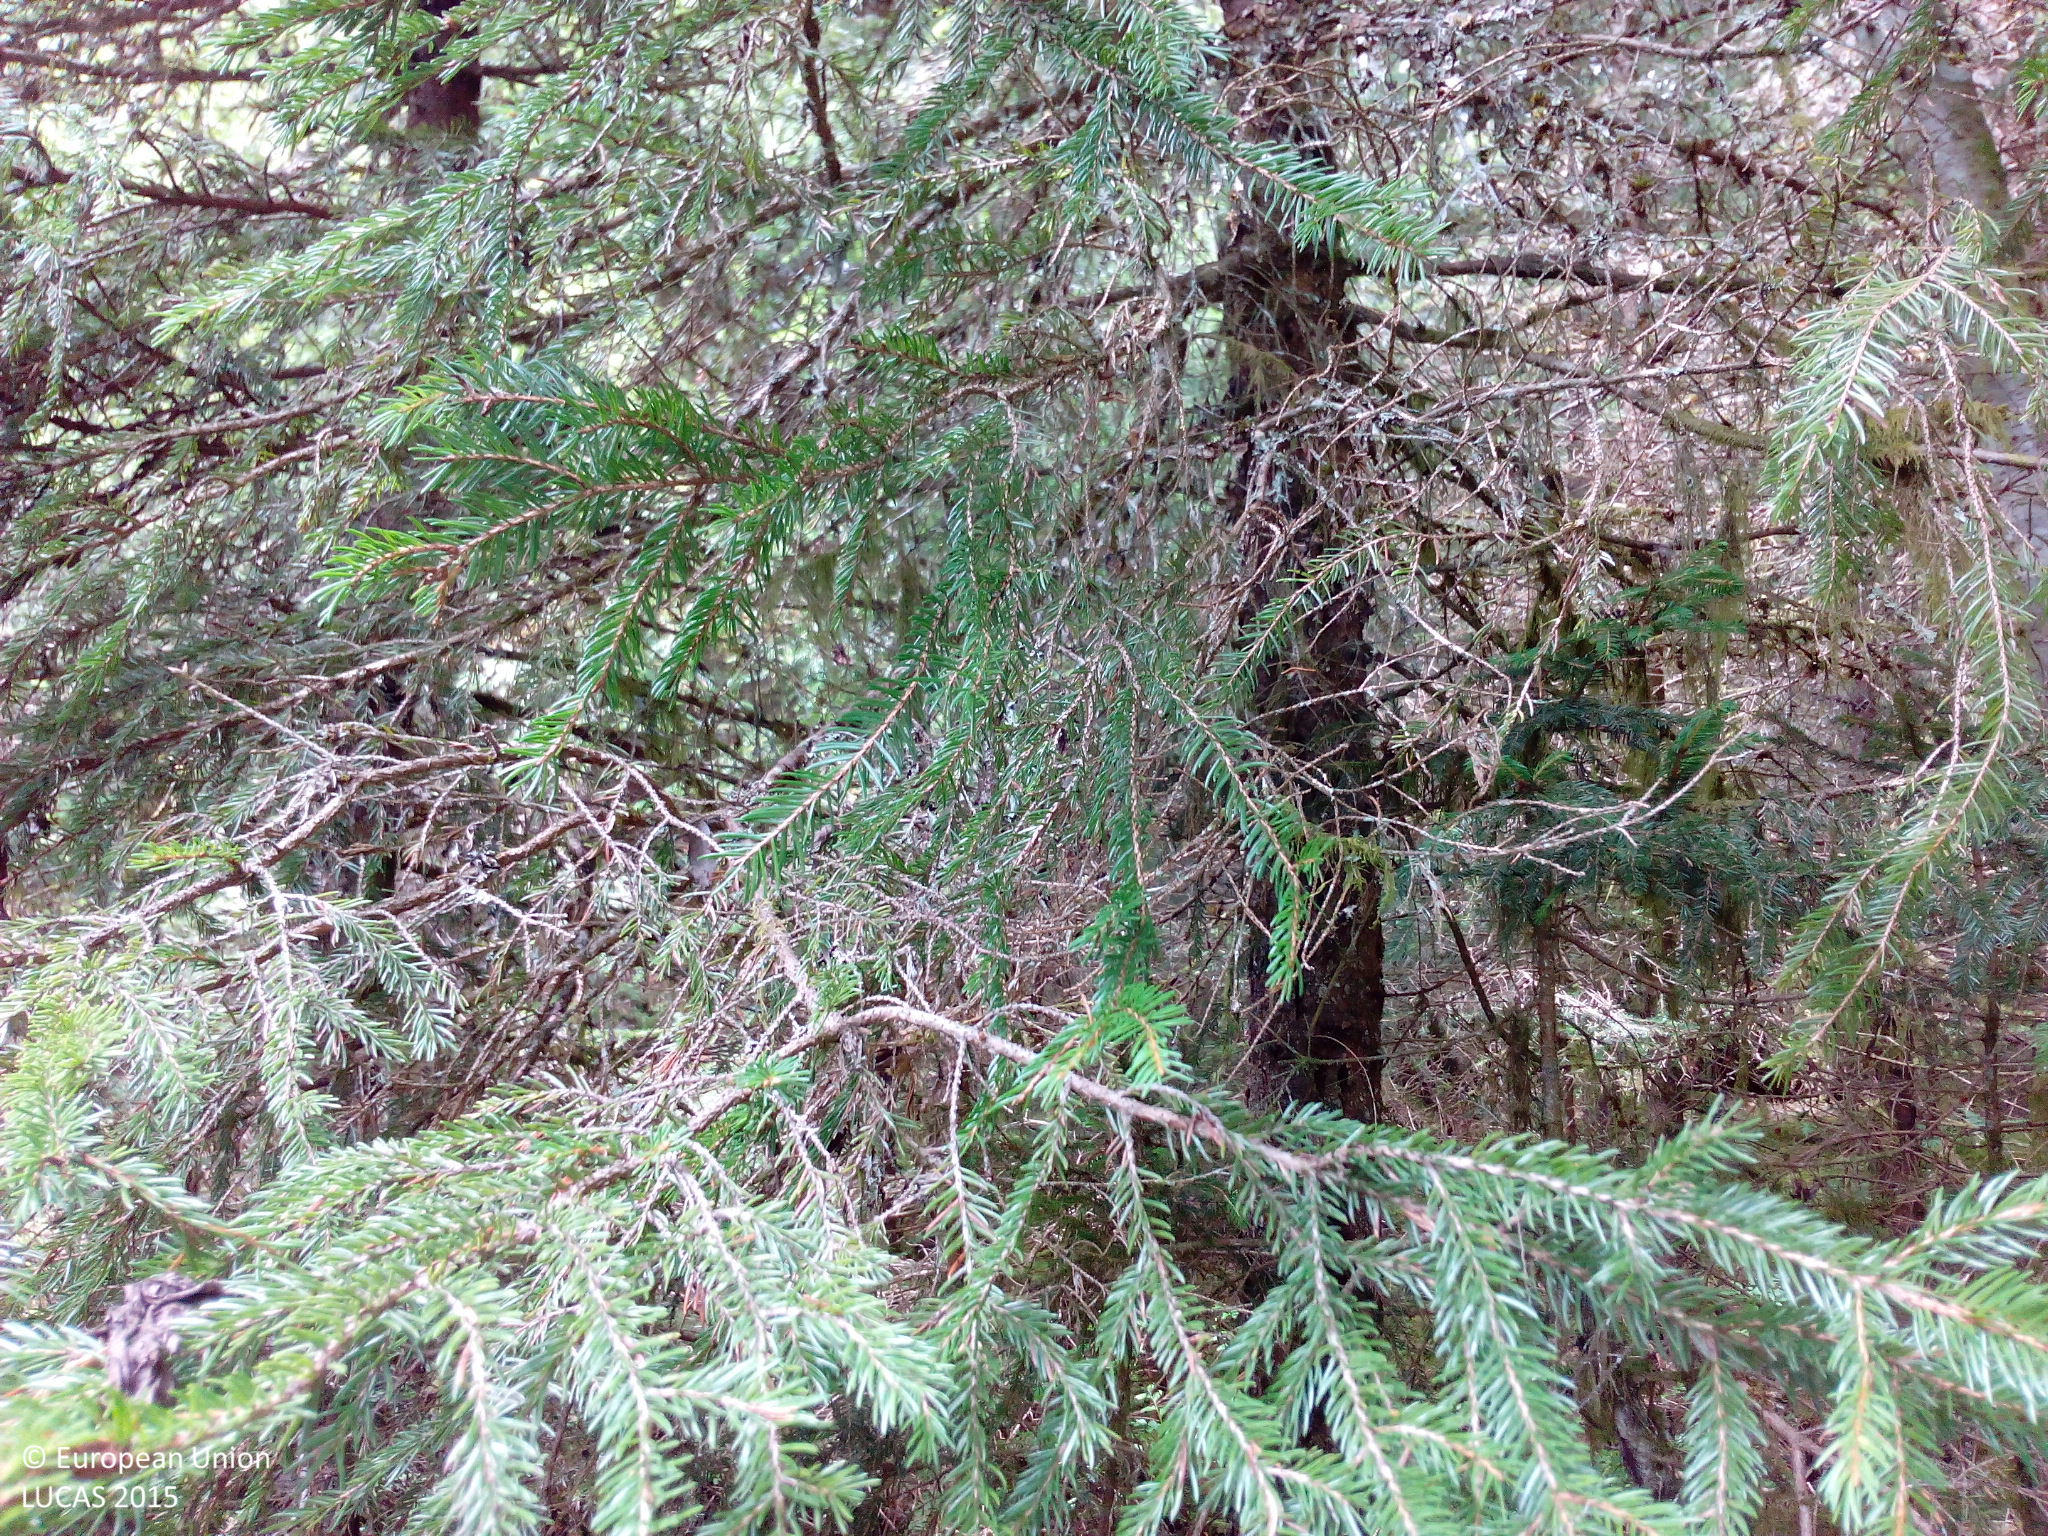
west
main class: Woodland
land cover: Spruce dominated coniferous woodland
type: hemiboreal forest and nemoral coniferous forest and mixed broadleaved-coniferous forest
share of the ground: > 75 %
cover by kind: coniferous forest trees 80 %, shrubs 10 %, lichens and mosses 10 %
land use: Semi-natural and natural areas not in use
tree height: > 5 m
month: August
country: DE
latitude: 47.7768
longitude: 8.1996
